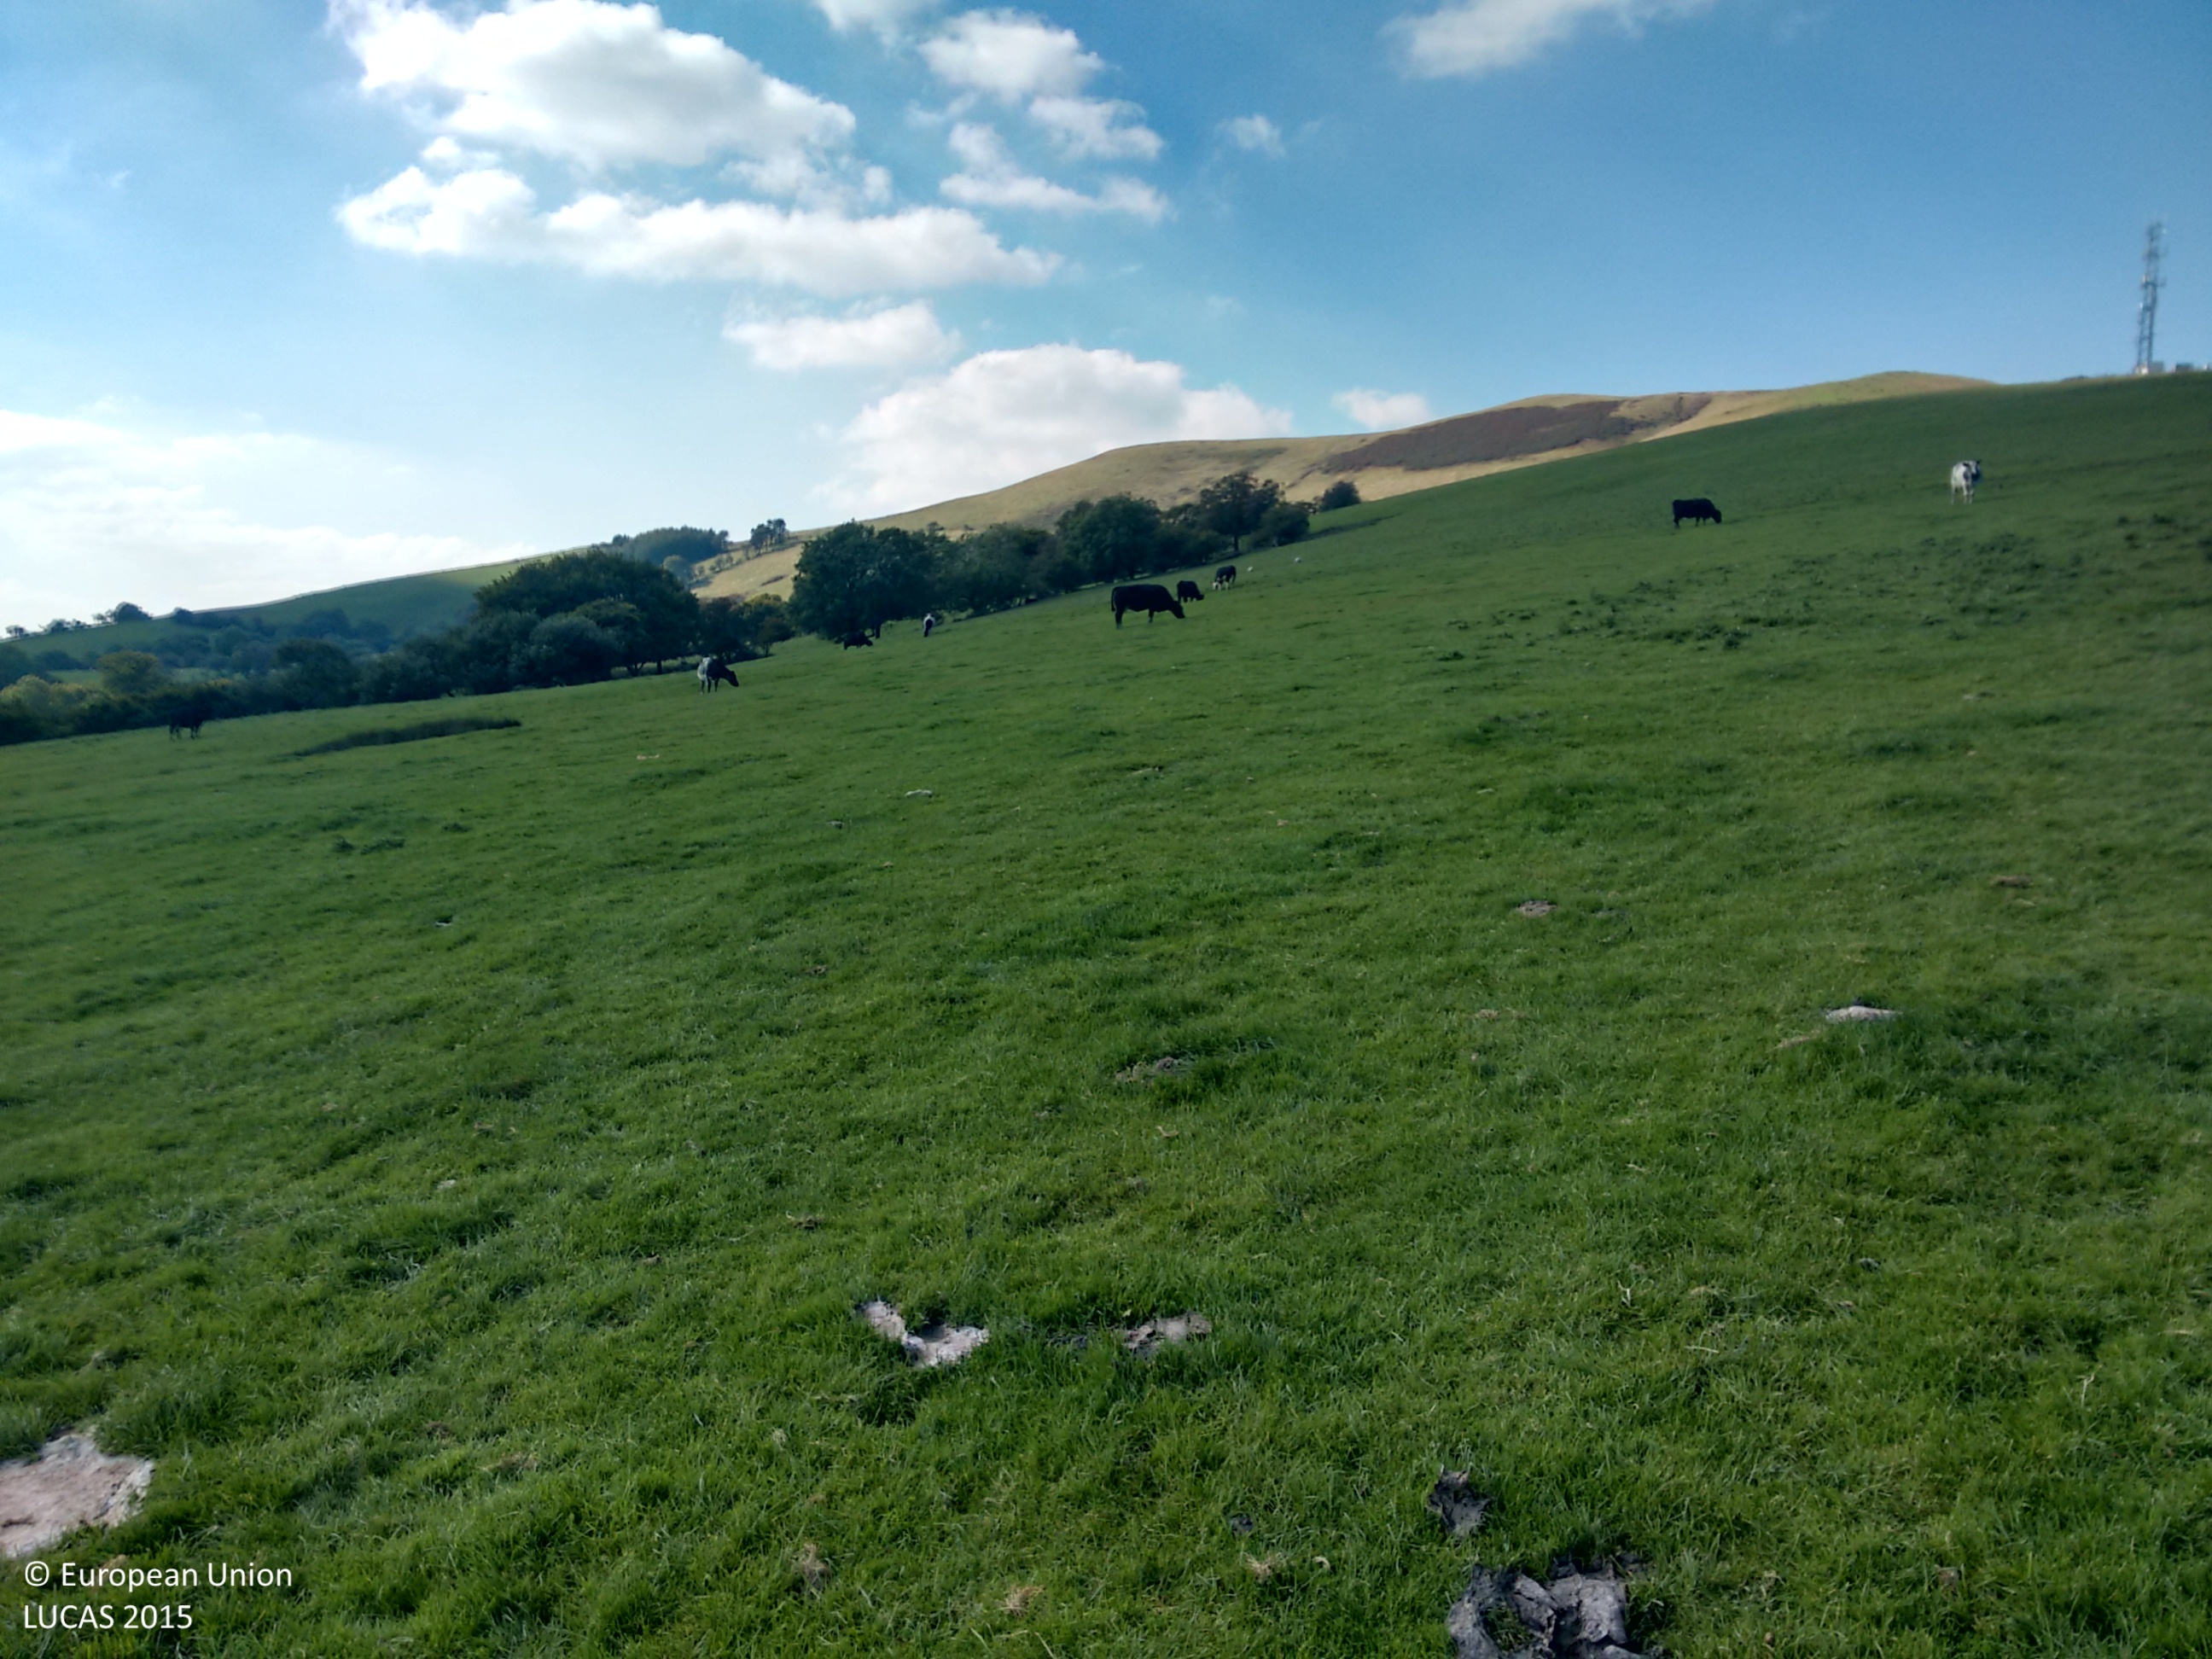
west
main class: Grassland
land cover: Grassland without tree/shrub cover
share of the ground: > 75 %
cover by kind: herbaceous plants 100 %
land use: Agriculture (excluding fallow land and kitchen gardens)
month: September
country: GB
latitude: 52.6260
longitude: -3.6339
